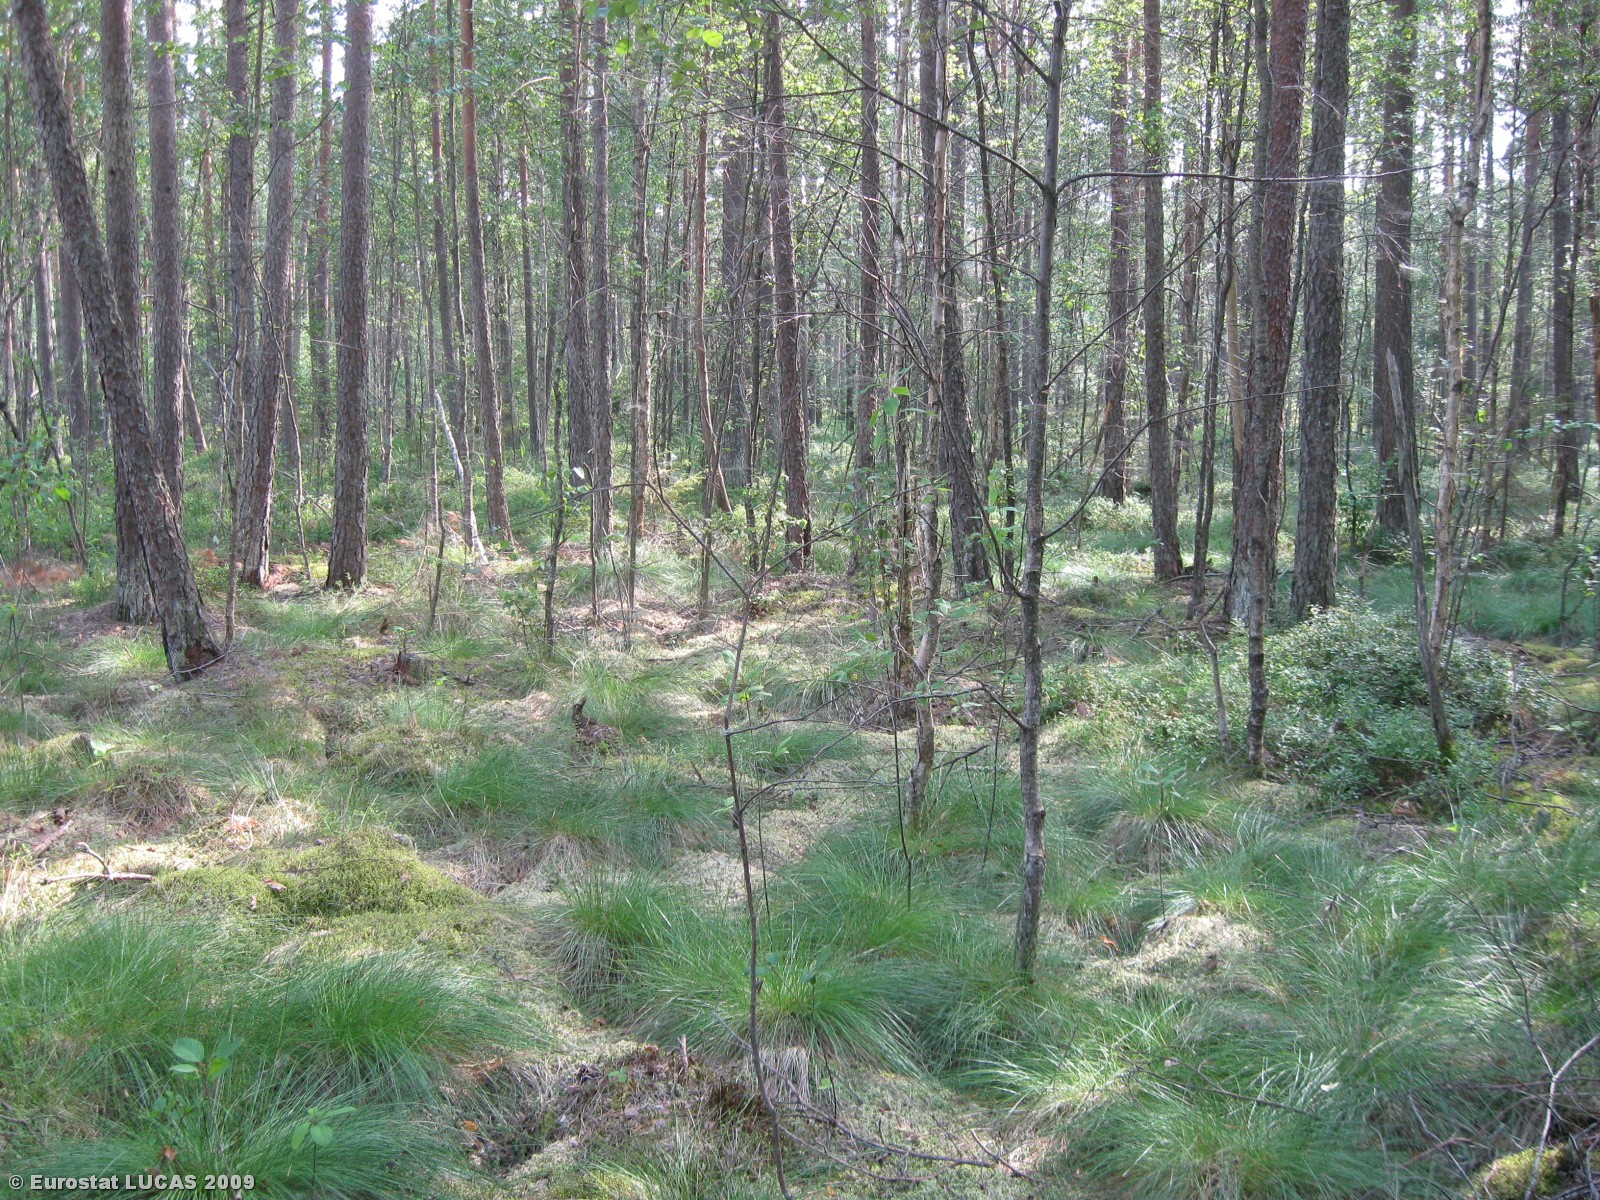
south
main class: Woodland
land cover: Mixed woodland
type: mire and swamp forests
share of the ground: > 75 %
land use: Forestry
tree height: > 5 m
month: July
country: LT
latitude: 54.3460
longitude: 25.1485
